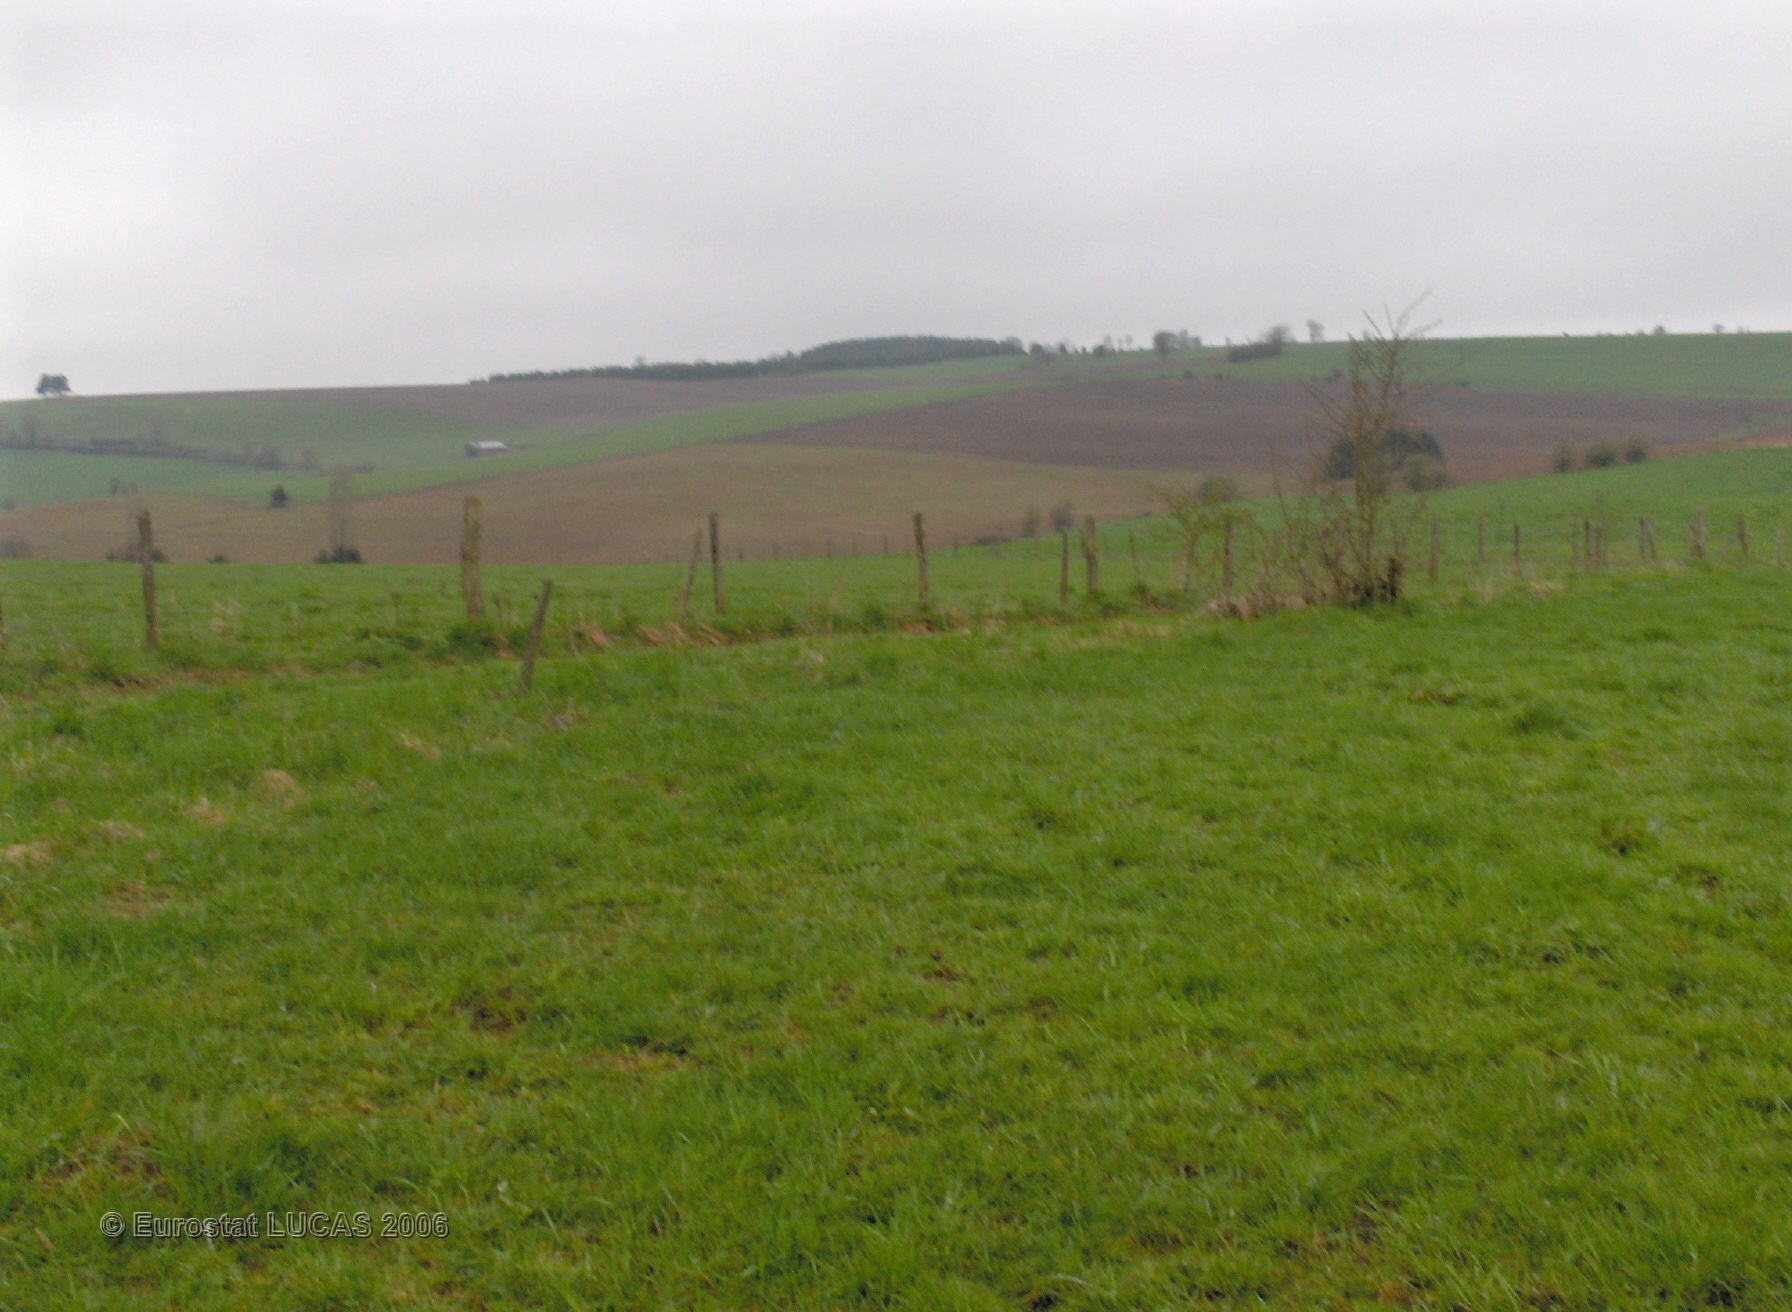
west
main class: Grassland
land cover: Grassland without tree/shrub cover
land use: Agriculture (excluding fallow land and kitchen gardens)
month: May
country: BE
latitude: 50.3233
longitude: 6.3335
